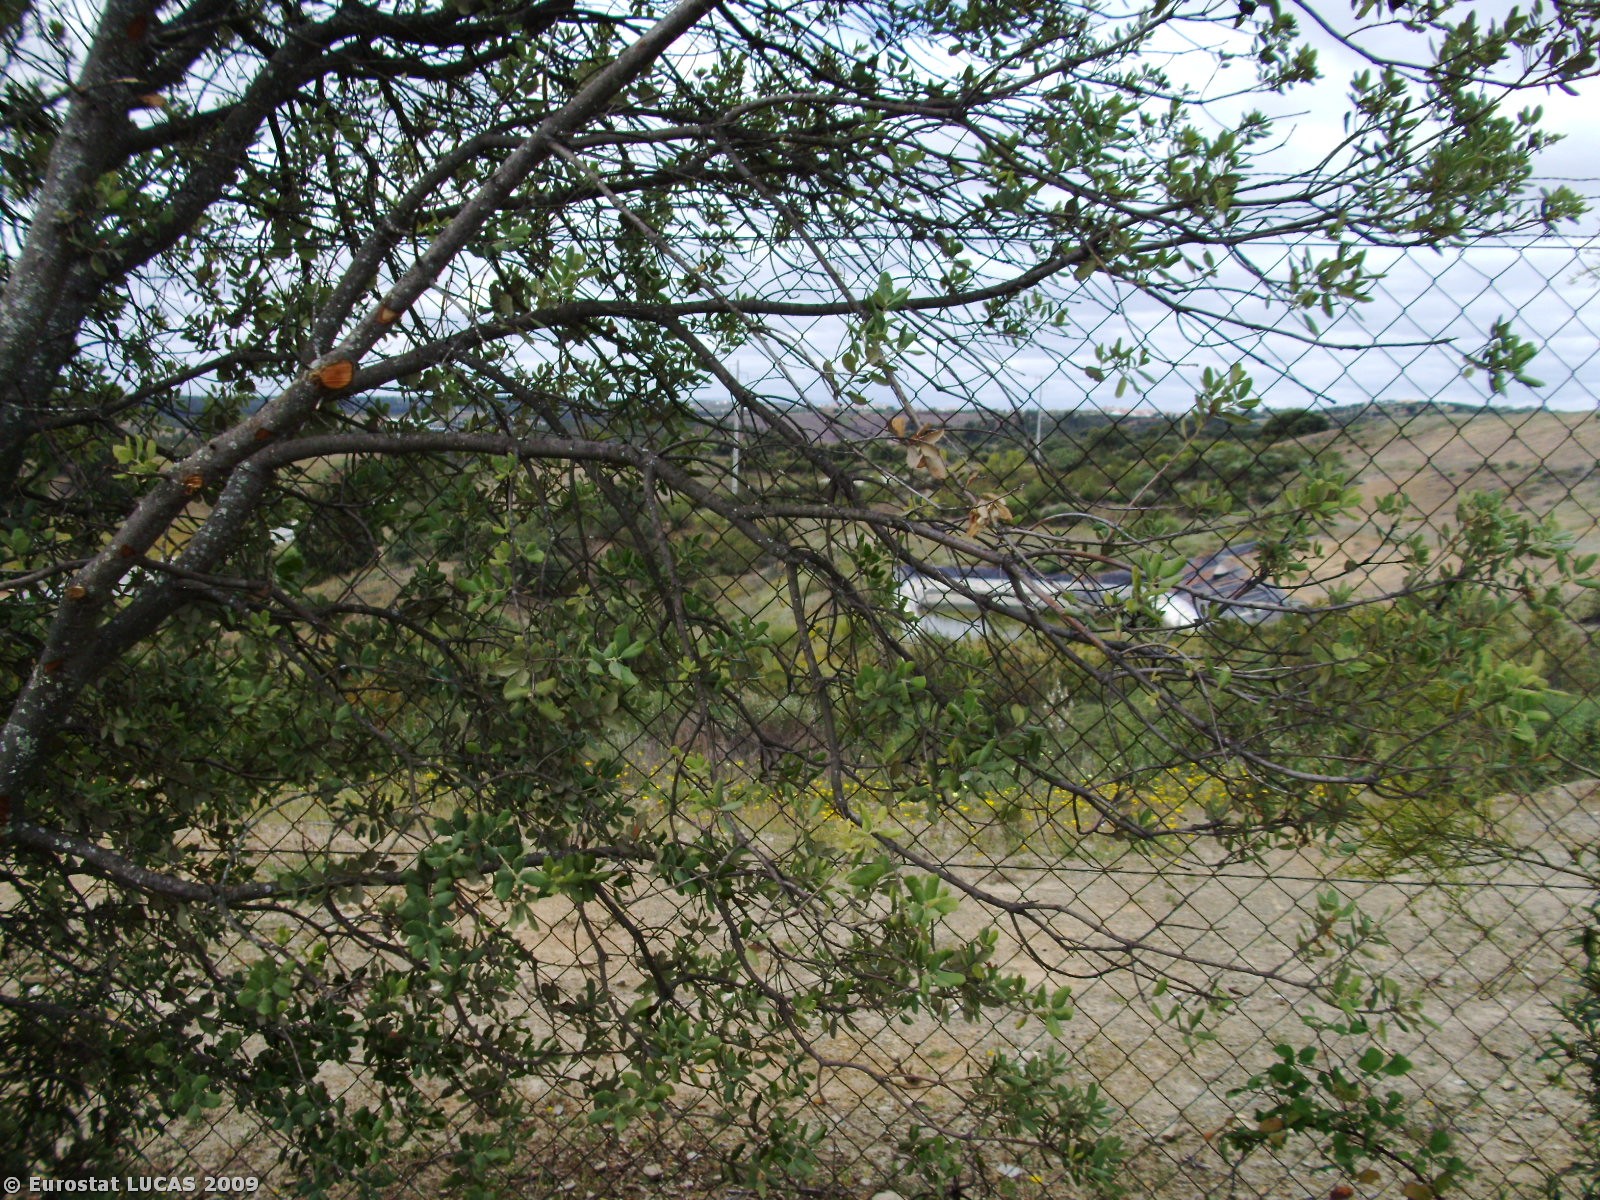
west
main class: Cropland
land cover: Olive groves
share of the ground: 25 - 50 %
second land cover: Spontaneously vegetated surfaces
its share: 50 - 75 %
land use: Agriculture (excluding fallow land and kitchen gardens)
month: April
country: PT
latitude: 39.7948
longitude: -7.4636
